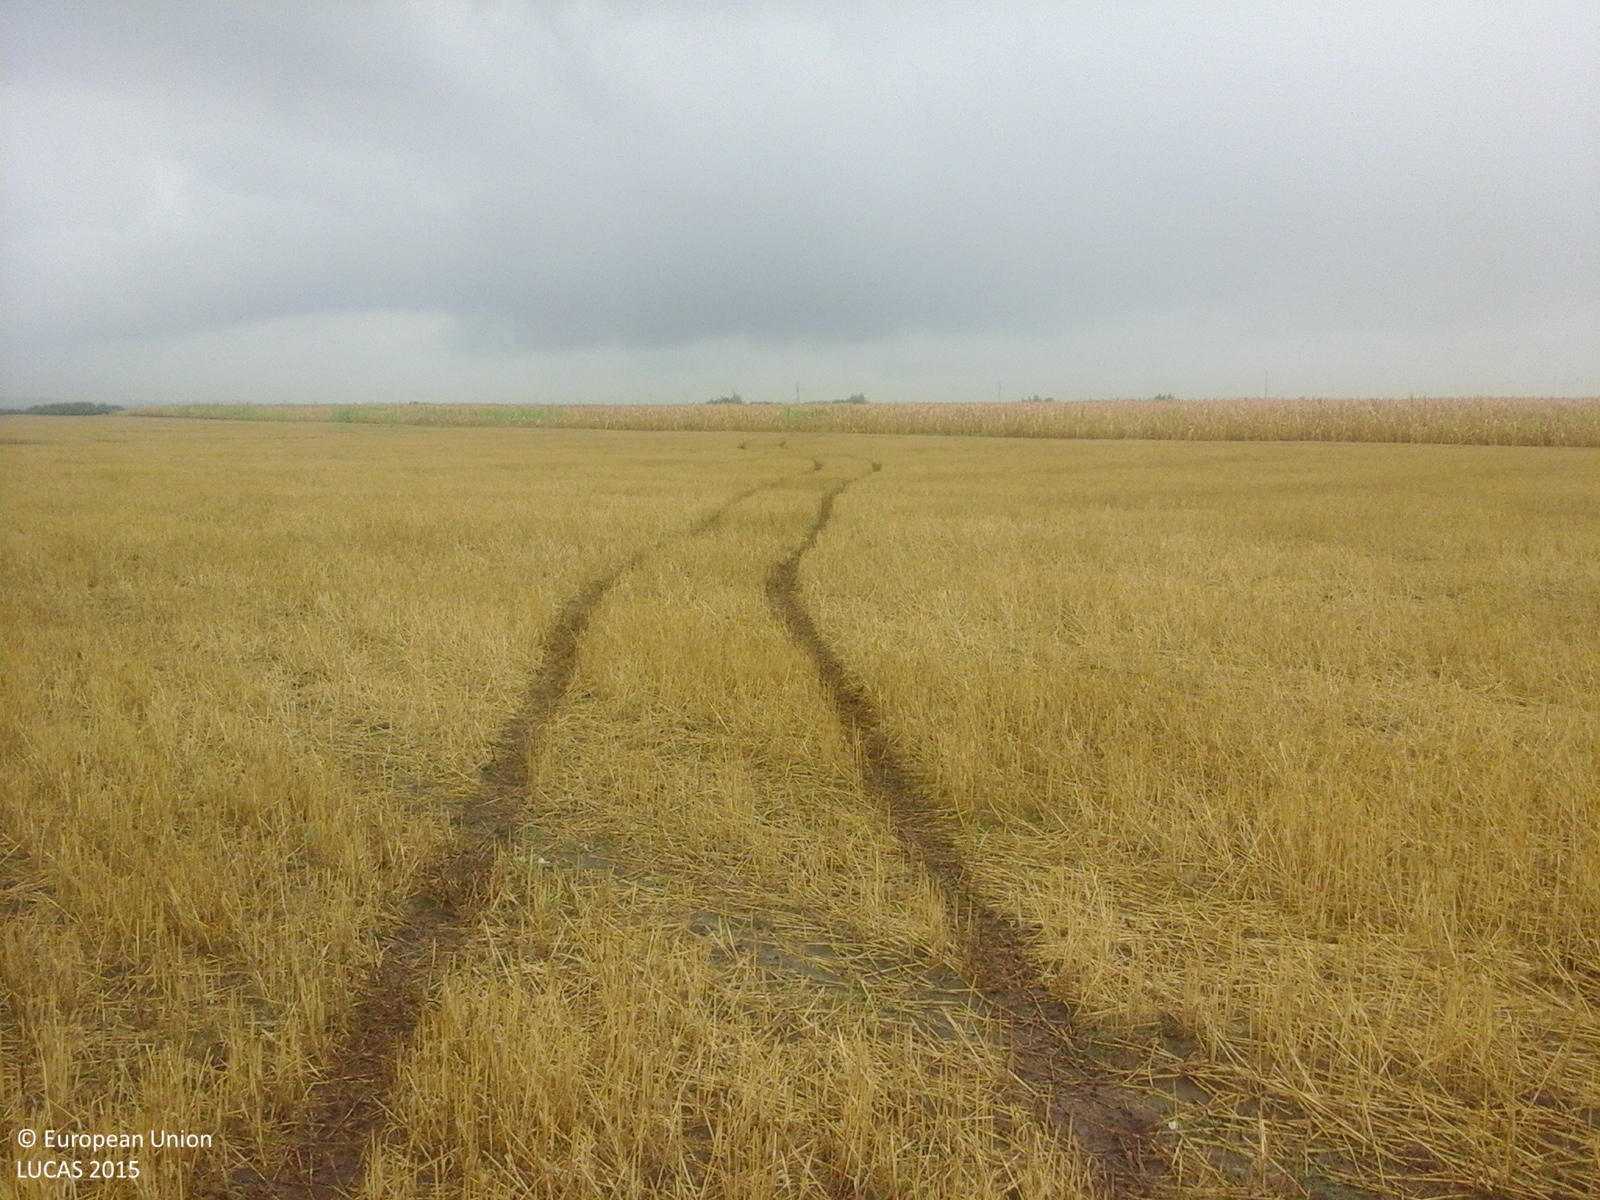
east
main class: Cropland
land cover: Common wheat
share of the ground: 50 - 75 %
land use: Agriculture (excluding fallow land and kitchen gardens)
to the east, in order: Common wheat; Maize
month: August
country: RO
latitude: 46.1010
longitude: 20.7250
